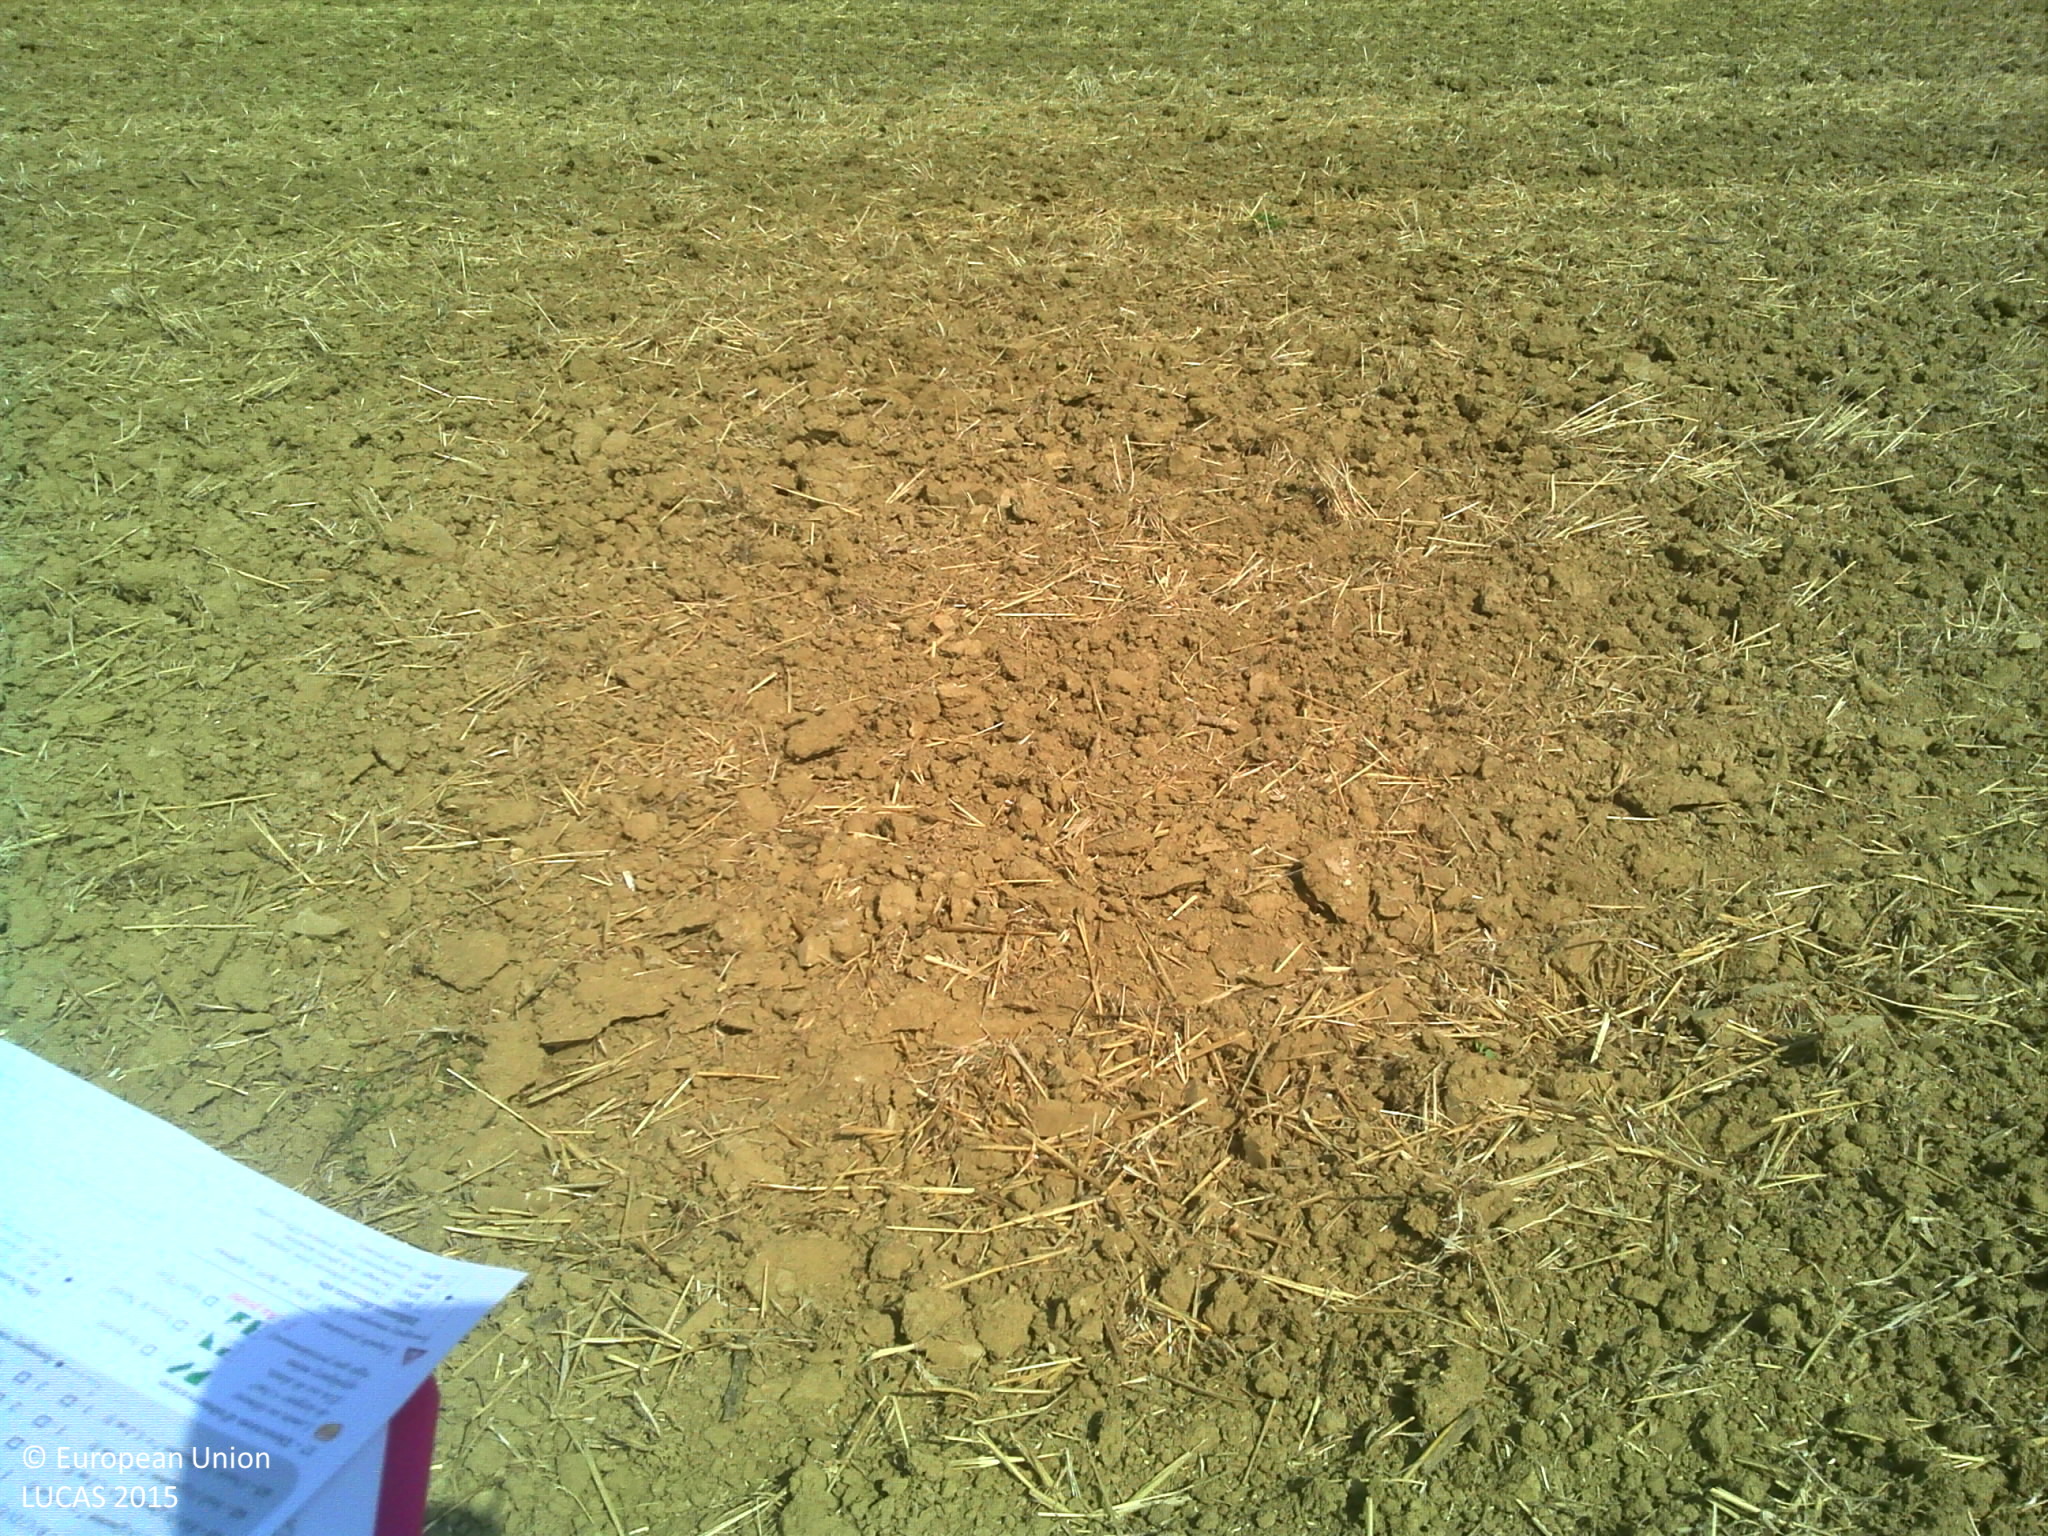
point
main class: Cropland
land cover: Common wheat
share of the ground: < 10 %
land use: Agriculture (excluding fallow land and kitchen gardens)
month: July
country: FR
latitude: 43.8504
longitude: 1.0051
